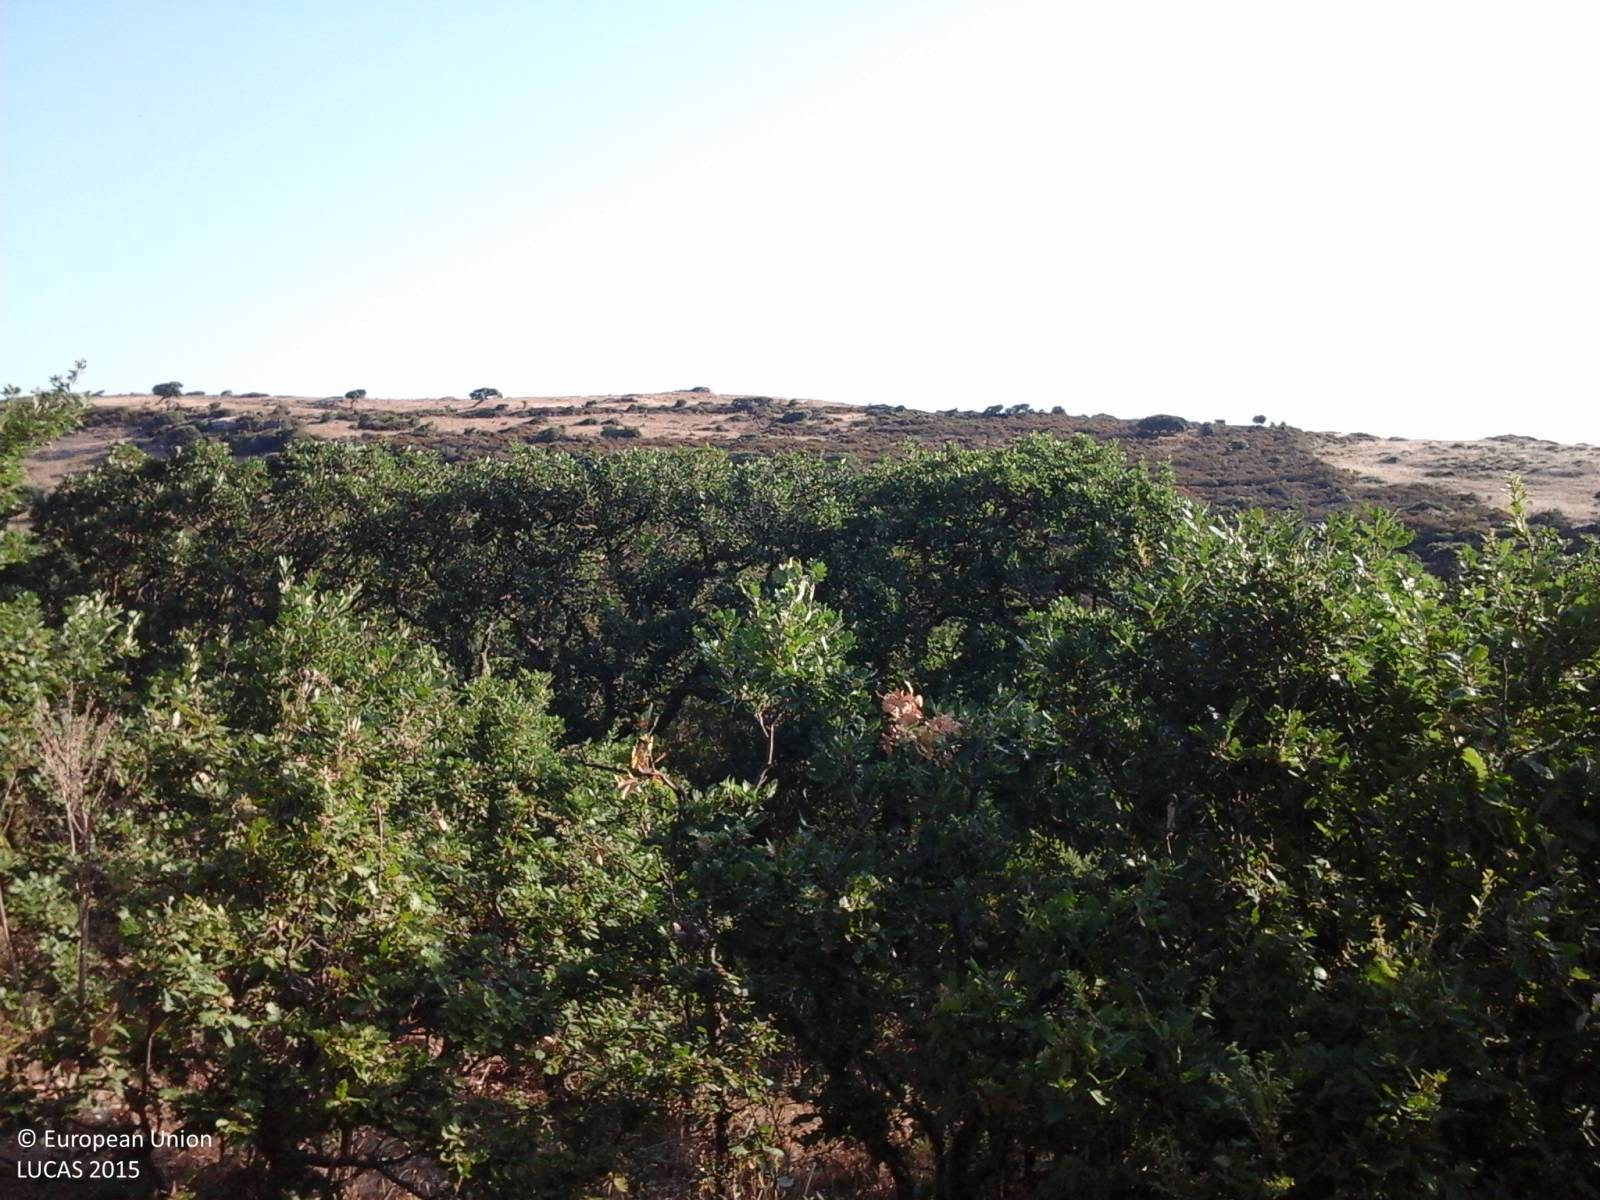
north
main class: Woodland
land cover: Broadleaved woodland
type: thermophilous deciduous forest
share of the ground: 25 - 50 %
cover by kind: broadleaved forest trees 45 %, herbaceous plants 35 %, shrubs 20 %
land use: Agriculture (excluding fallow land and kitchen gardens)
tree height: < 5 m
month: July
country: IT
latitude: 40.4725
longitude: 8.4626
